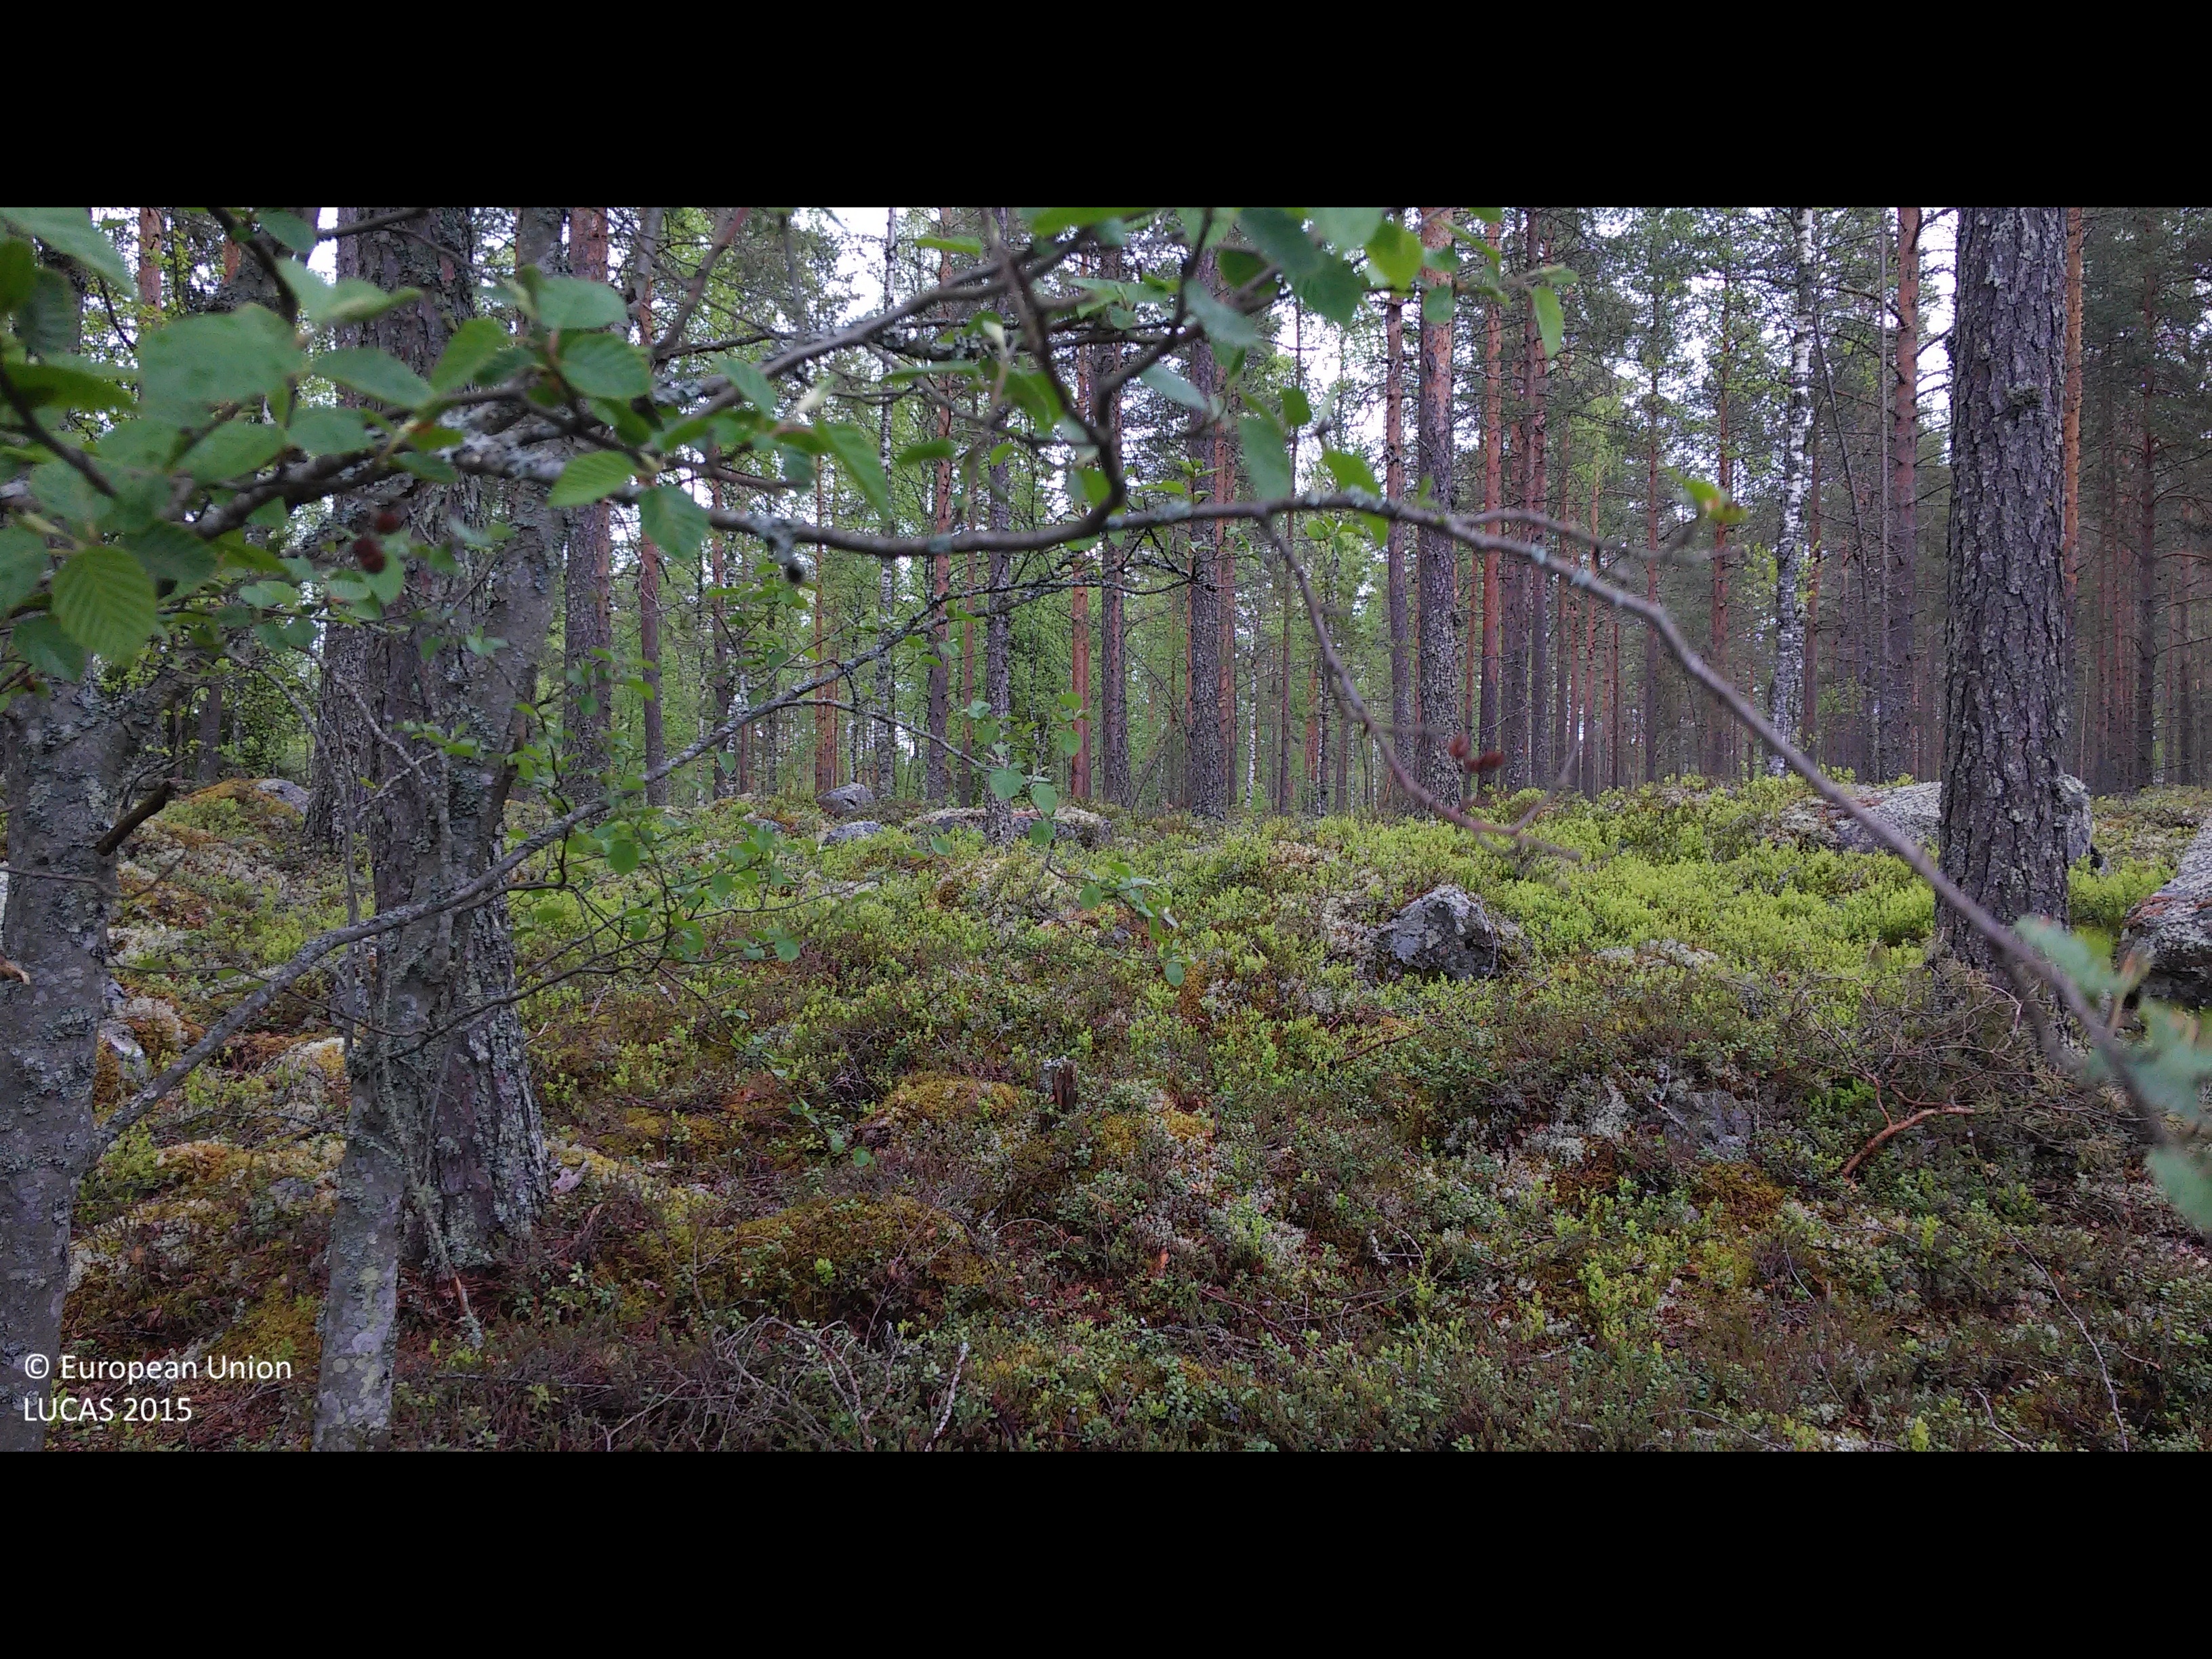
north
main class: Woodland
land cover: Pine dominated coniferous woodland
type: boreal forest
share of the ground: > 75 %
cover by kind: coniferous forest trees 80 %, broadleaved forest trees 5 %, herbaceous plants 5 %, lichens and mosses 5 %, unconsolidated bare surface 5 %
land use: Forestry
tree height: > 5 m
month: June
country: FI
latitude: 63.7486
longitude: 24.0718
